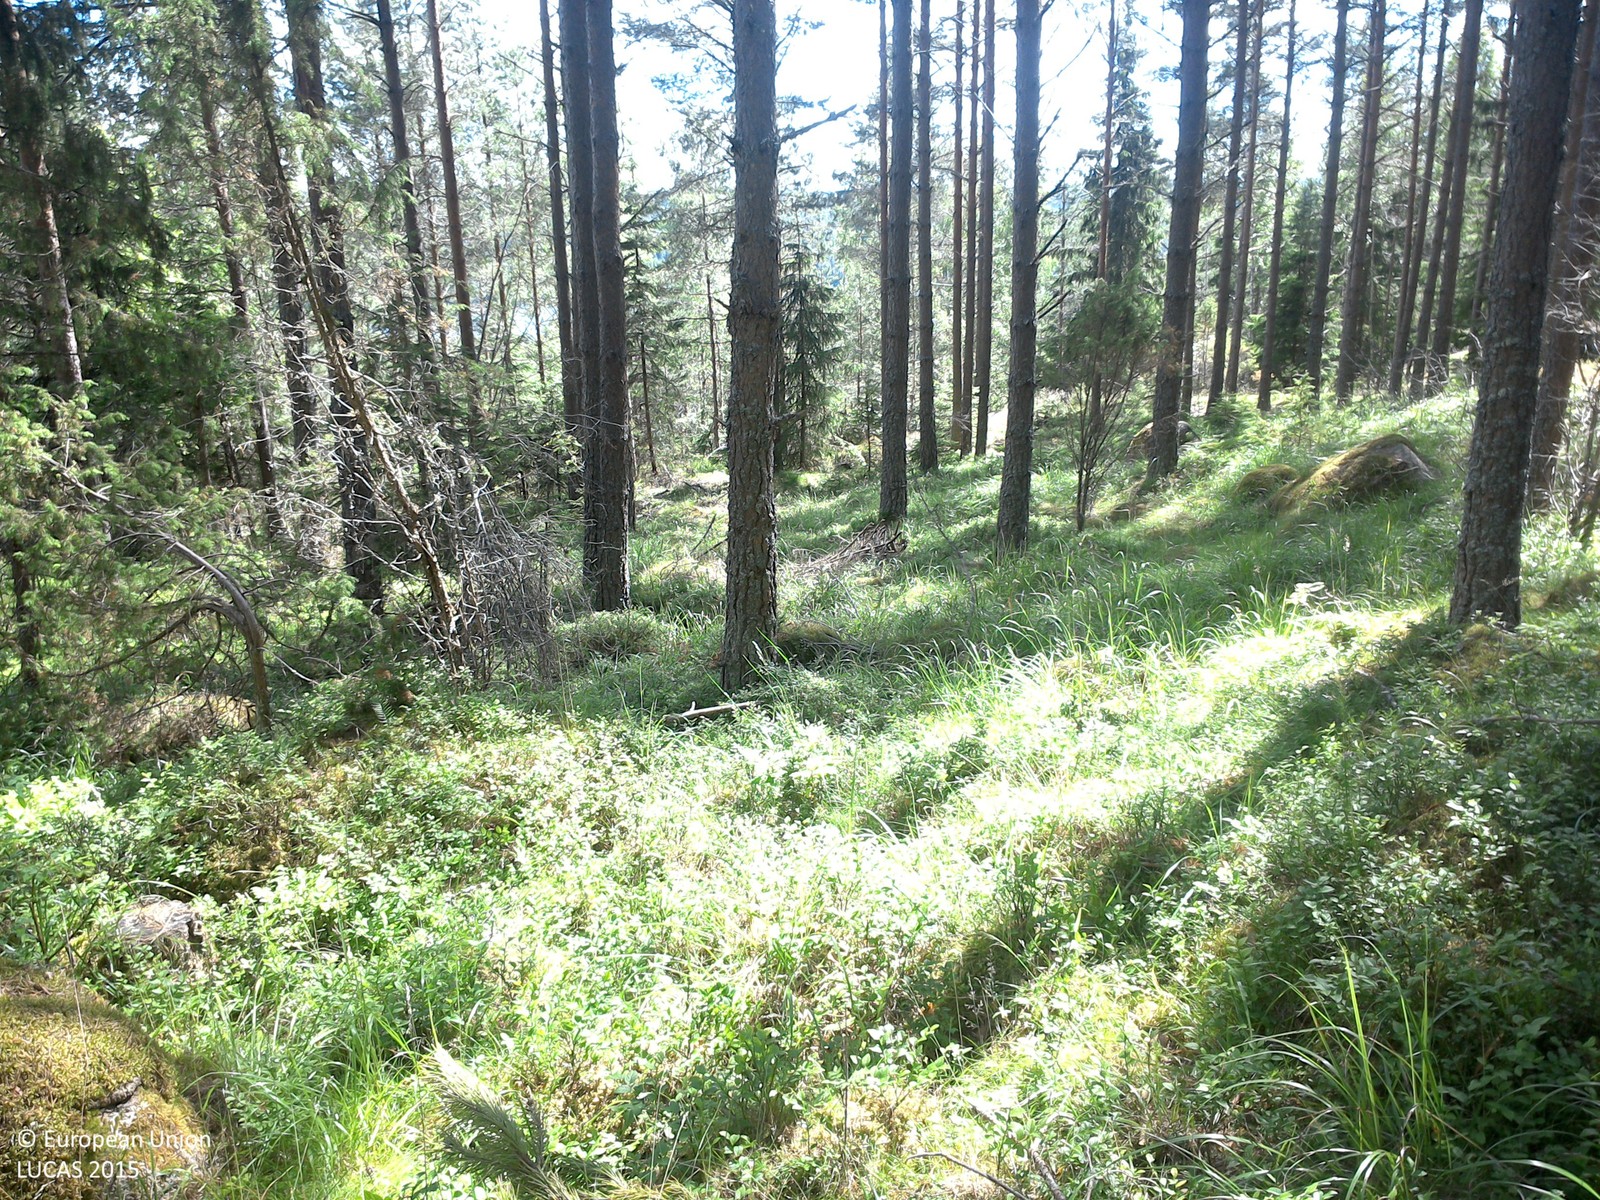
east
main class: Woodland
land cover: Pine dominated coniferous woodland
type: boreal forest
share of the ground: 50 - 75 %
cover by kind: coniferous forest trees 70 %, herbaceous plants 30 %
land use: Forestry
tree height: > 5 m
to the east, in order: Pine dominated coniferous woodland; Pine dominated mixed woodland; Rocks and stones; Spruce dominated mixed woodland; Pine dominated coniferous woodland; Spruce dominated coniferous woodland; Grassland with sparse tree/shrub cover; Electric lines; Groves; Grass margins; Paved roads, cycling and walking lanes; Ditches and canals; Pine dominated coniferous woodland; Spruce dominated coniferous woodland
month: June
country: SE
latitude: 57.9804
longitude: 15.9318
